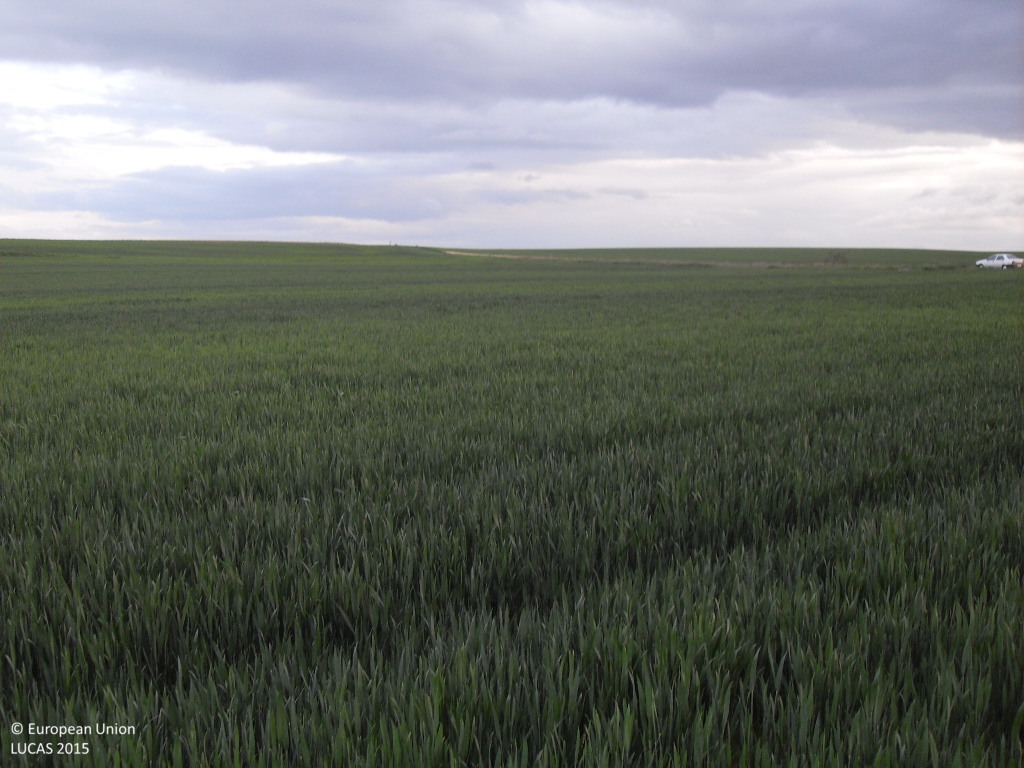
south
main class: Cropland
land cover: Common wheat
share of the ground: > 75 %
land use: Agriculture (excluding fallow land and kitchen gardens)
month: April
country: ES
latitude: 40.9994
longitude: -5.2271
